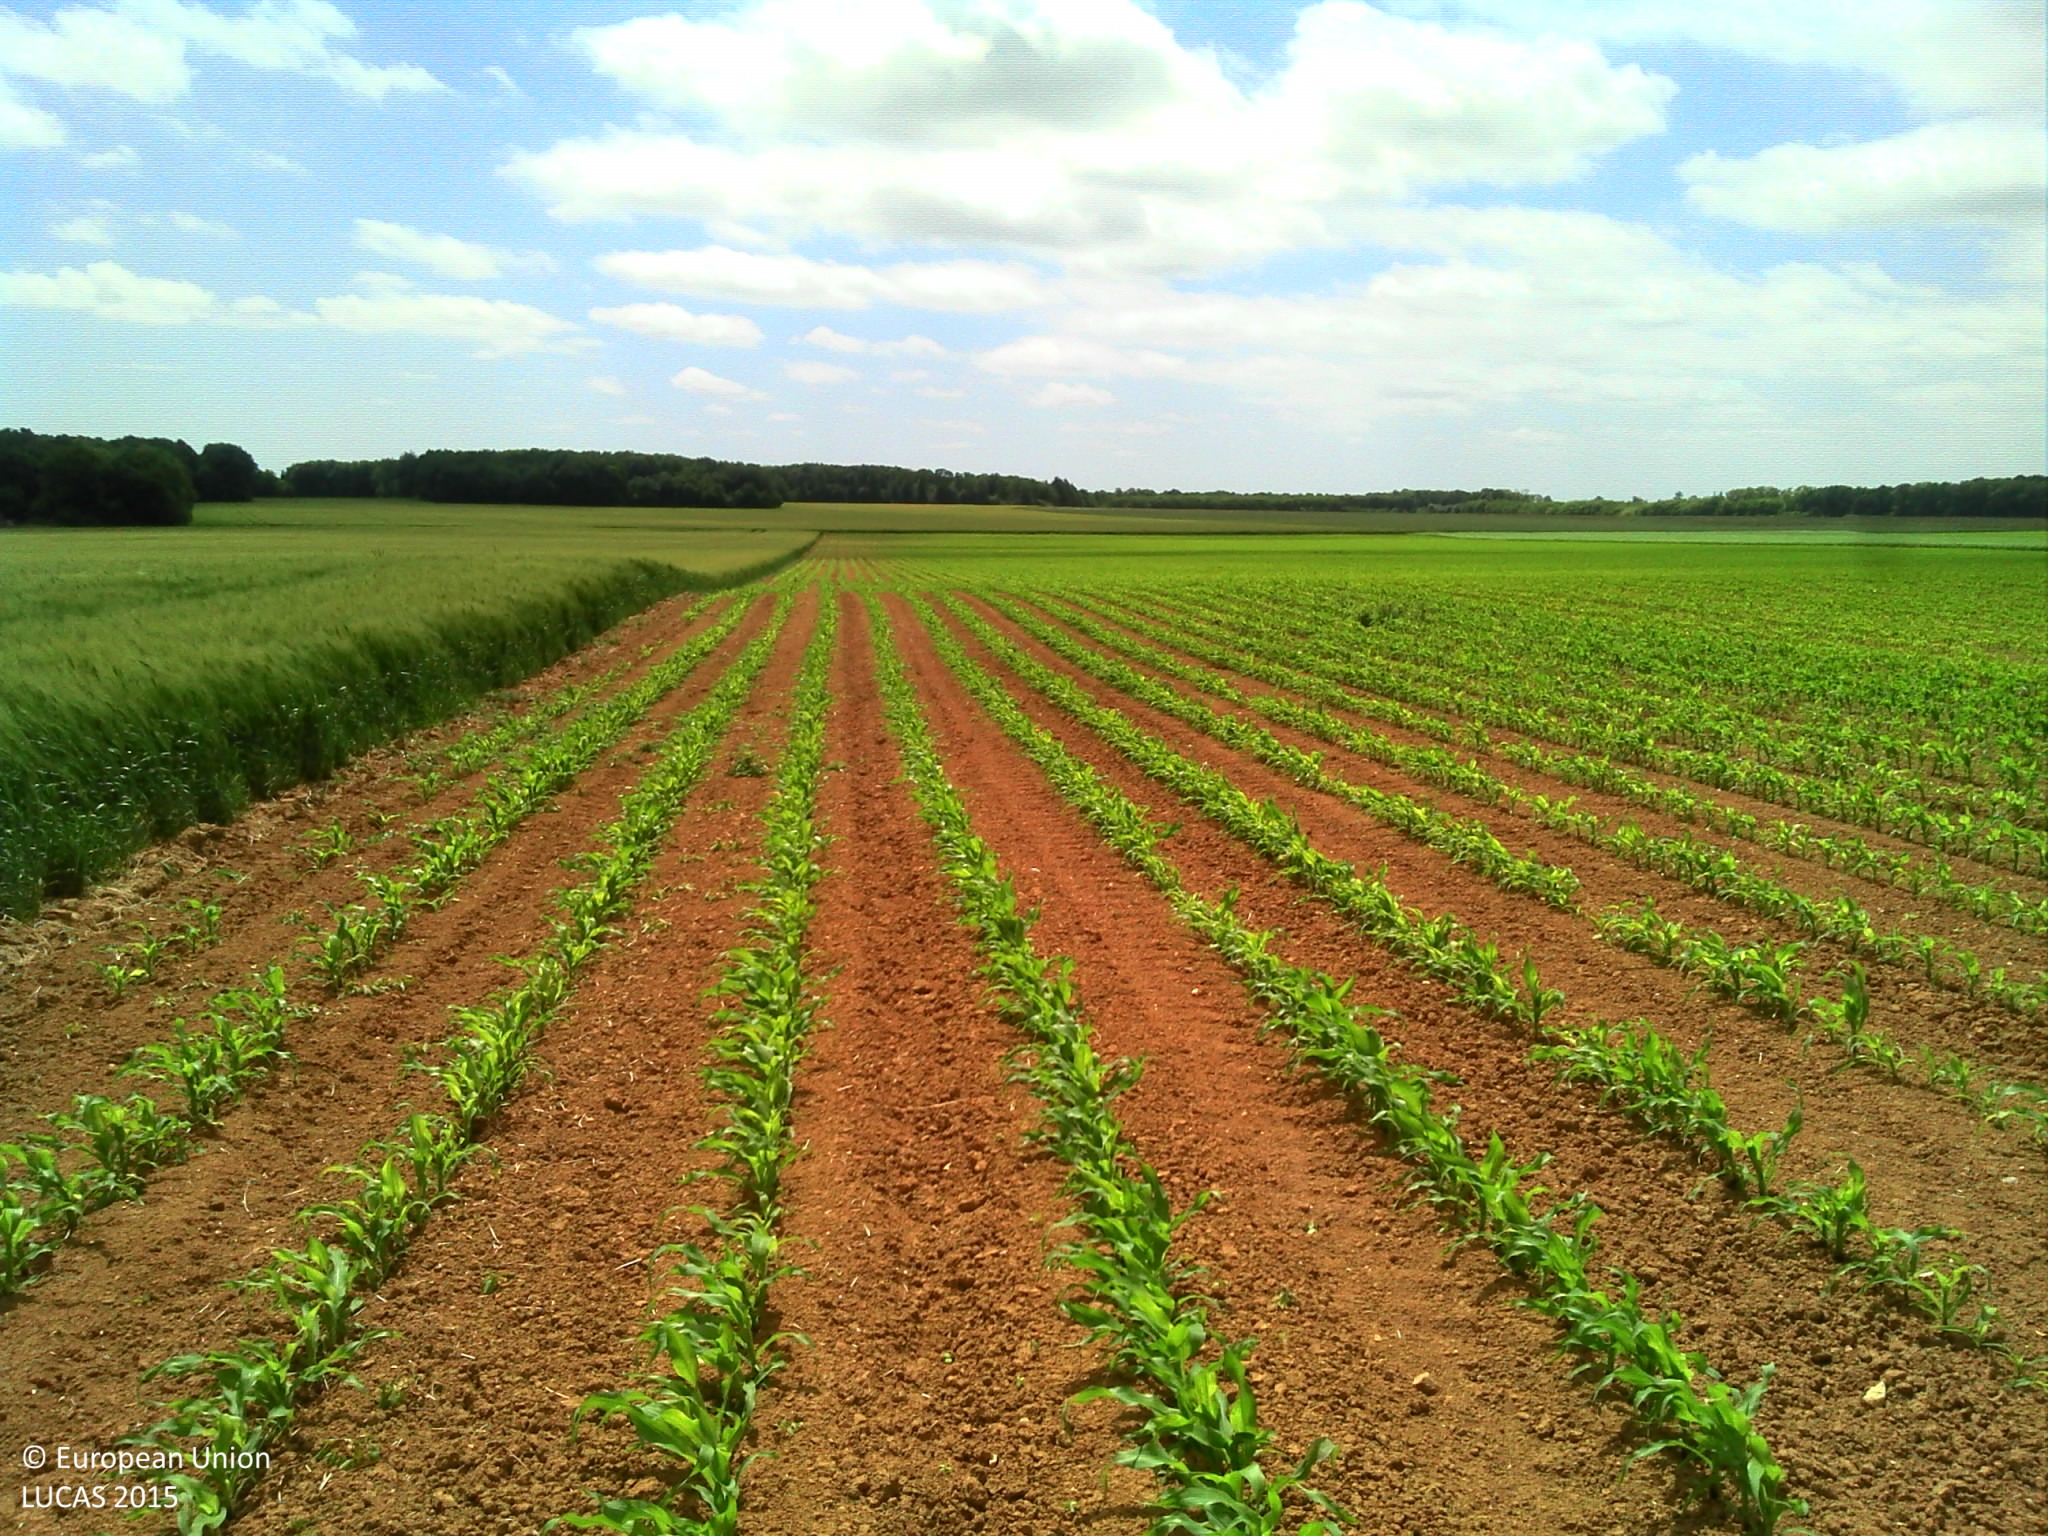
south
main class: Cropland
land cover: Maize
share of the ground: 25 - 50 %
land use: Agriculture (excluding fallow land and kitchen gardens)
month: June
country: FR
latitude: 48.1284
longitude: 1.4791
